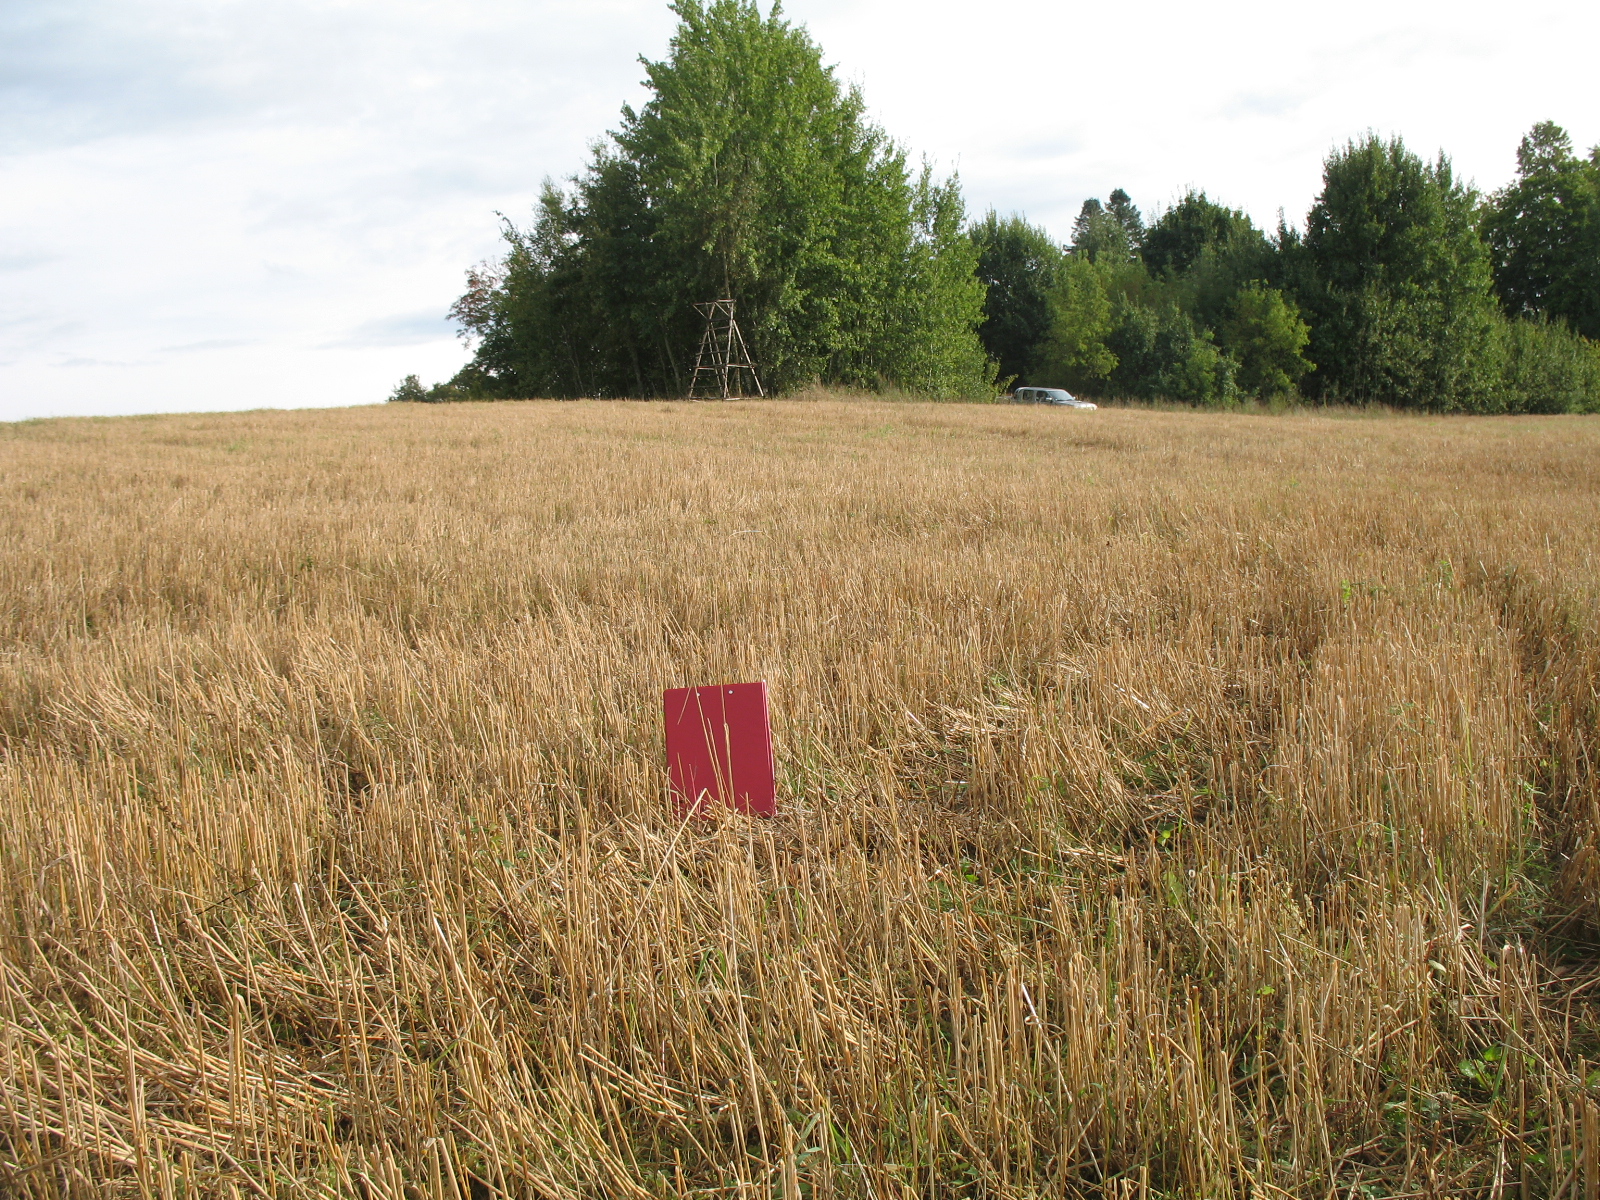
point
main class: Cropland
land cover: Common wheat
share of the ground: 10 - 25 %
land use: Agriculture (excluding fallow land and kitchen gardens)
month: September
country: LV
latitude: 56.0833
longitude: 25.9297
